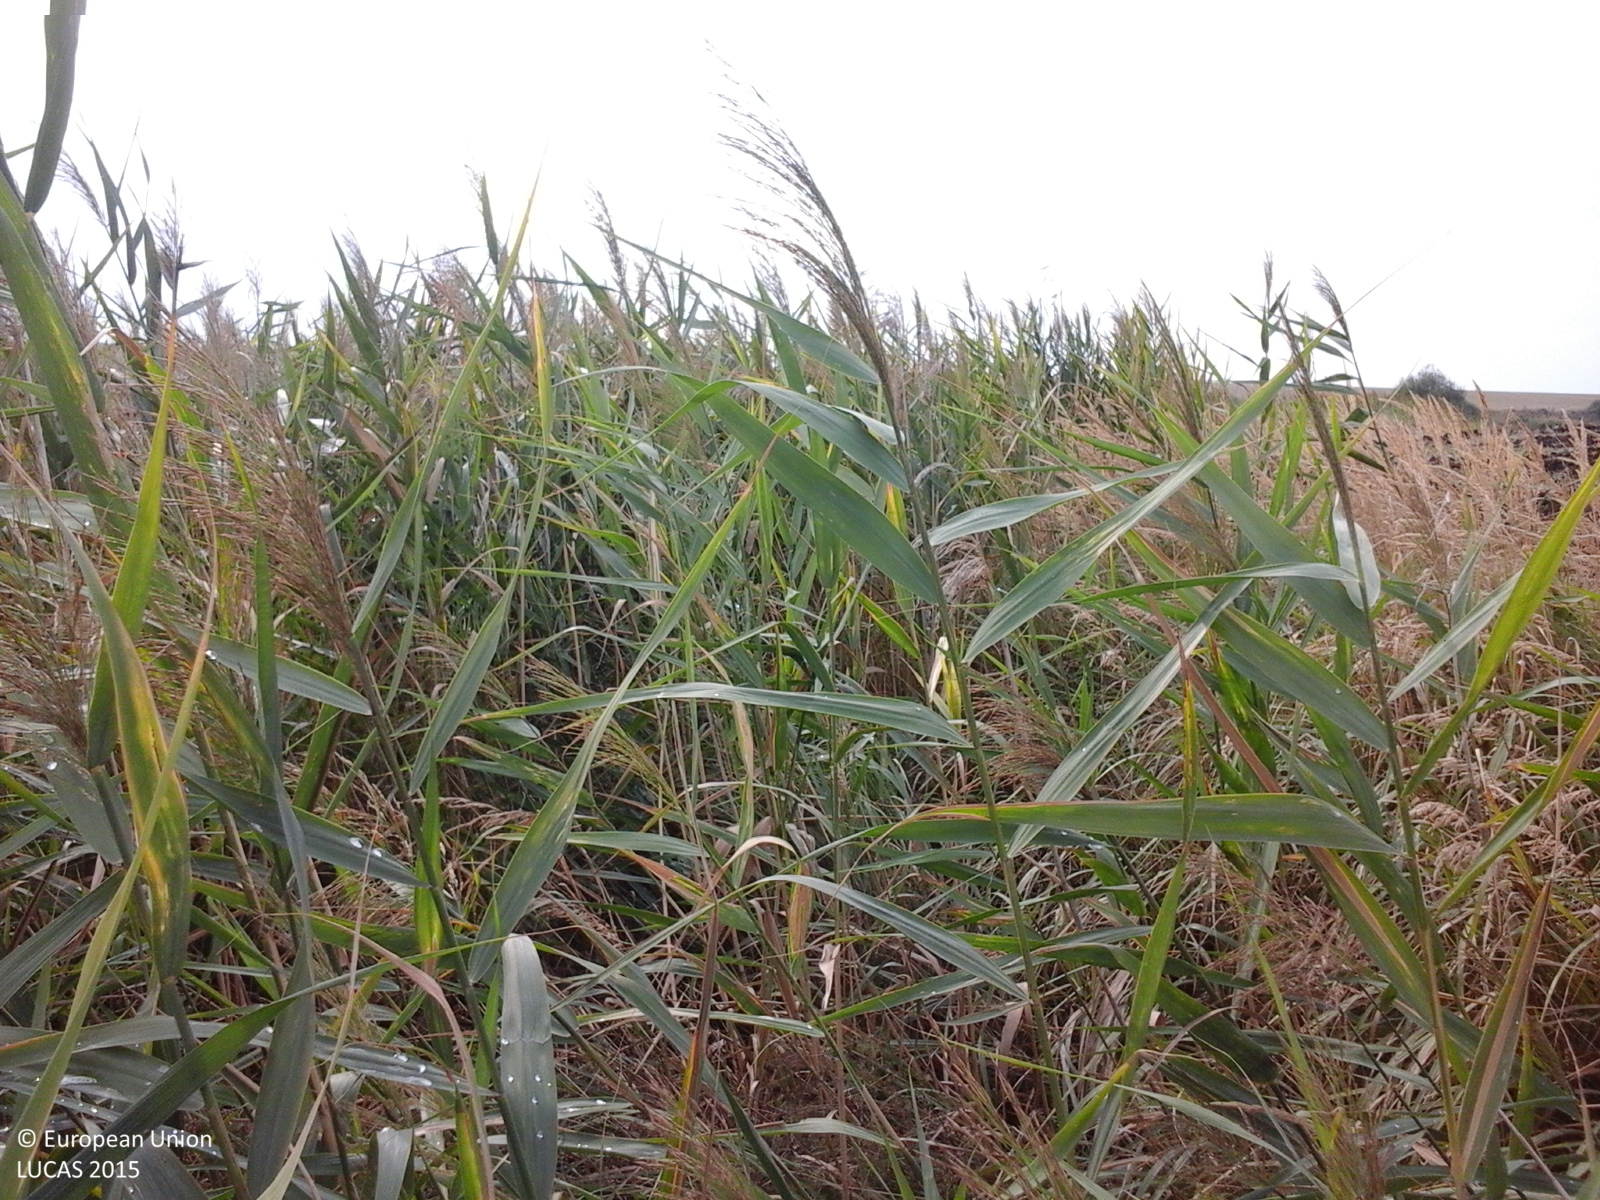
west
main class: Grassland
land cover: Spontaneously vegetated surfaces
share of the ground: > 75 %
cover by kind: herbaceous plants 100 %
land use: Semi-natural and natural areas not in use
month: August
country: RO
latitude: 45.8688
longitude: 21.3820
